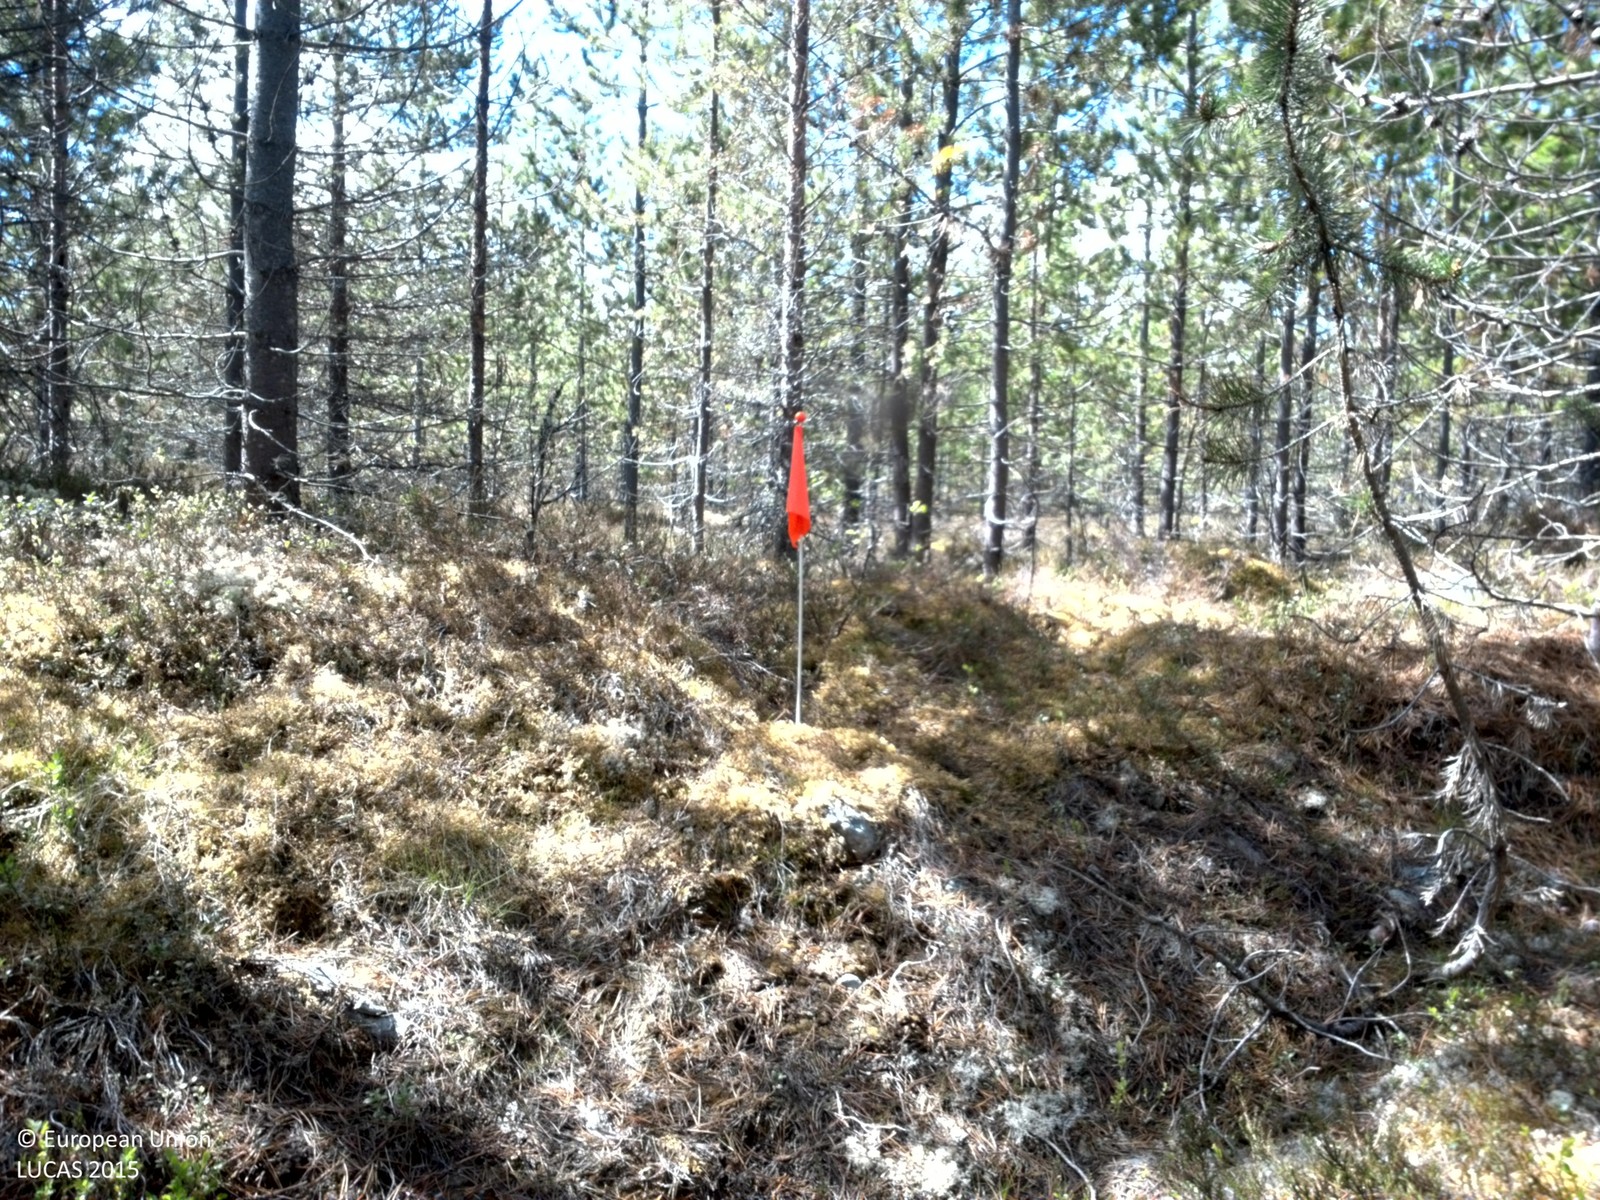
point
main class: Woodland
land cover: Pine dominated coniferous woodland
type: exotic forest
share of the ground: 50 - 75 %
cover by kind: coniferous forest trees 75 %, shrubs 15 %, lichens and mosses 10 %
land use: Forestry
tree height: > 5 m
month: June
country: SE
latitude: 61.9642
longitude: 12.2599
